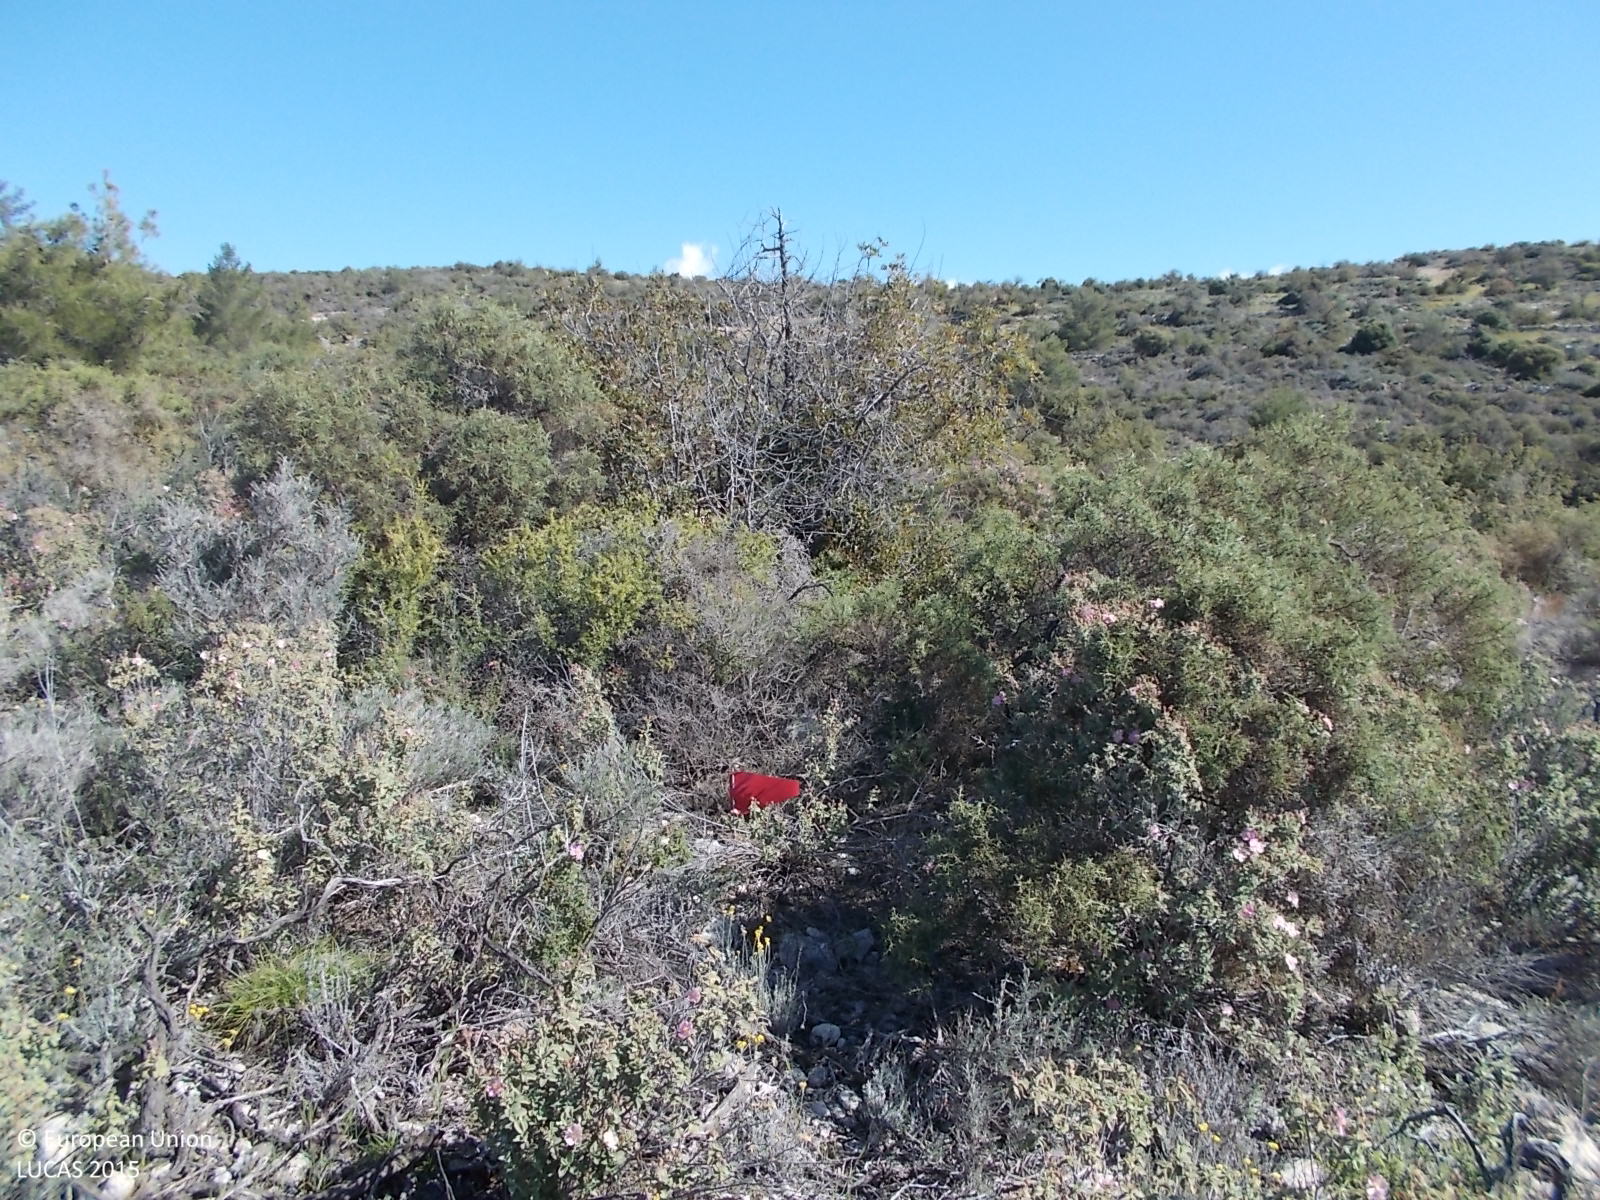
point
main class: Shrubland
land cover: Shrubland without tree cover
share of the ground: > 75 %
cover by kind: shrubs 100 %
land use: Semi-natural and natural areas not in use
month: April
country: CY
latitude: 34.7609
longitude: 33.0560
